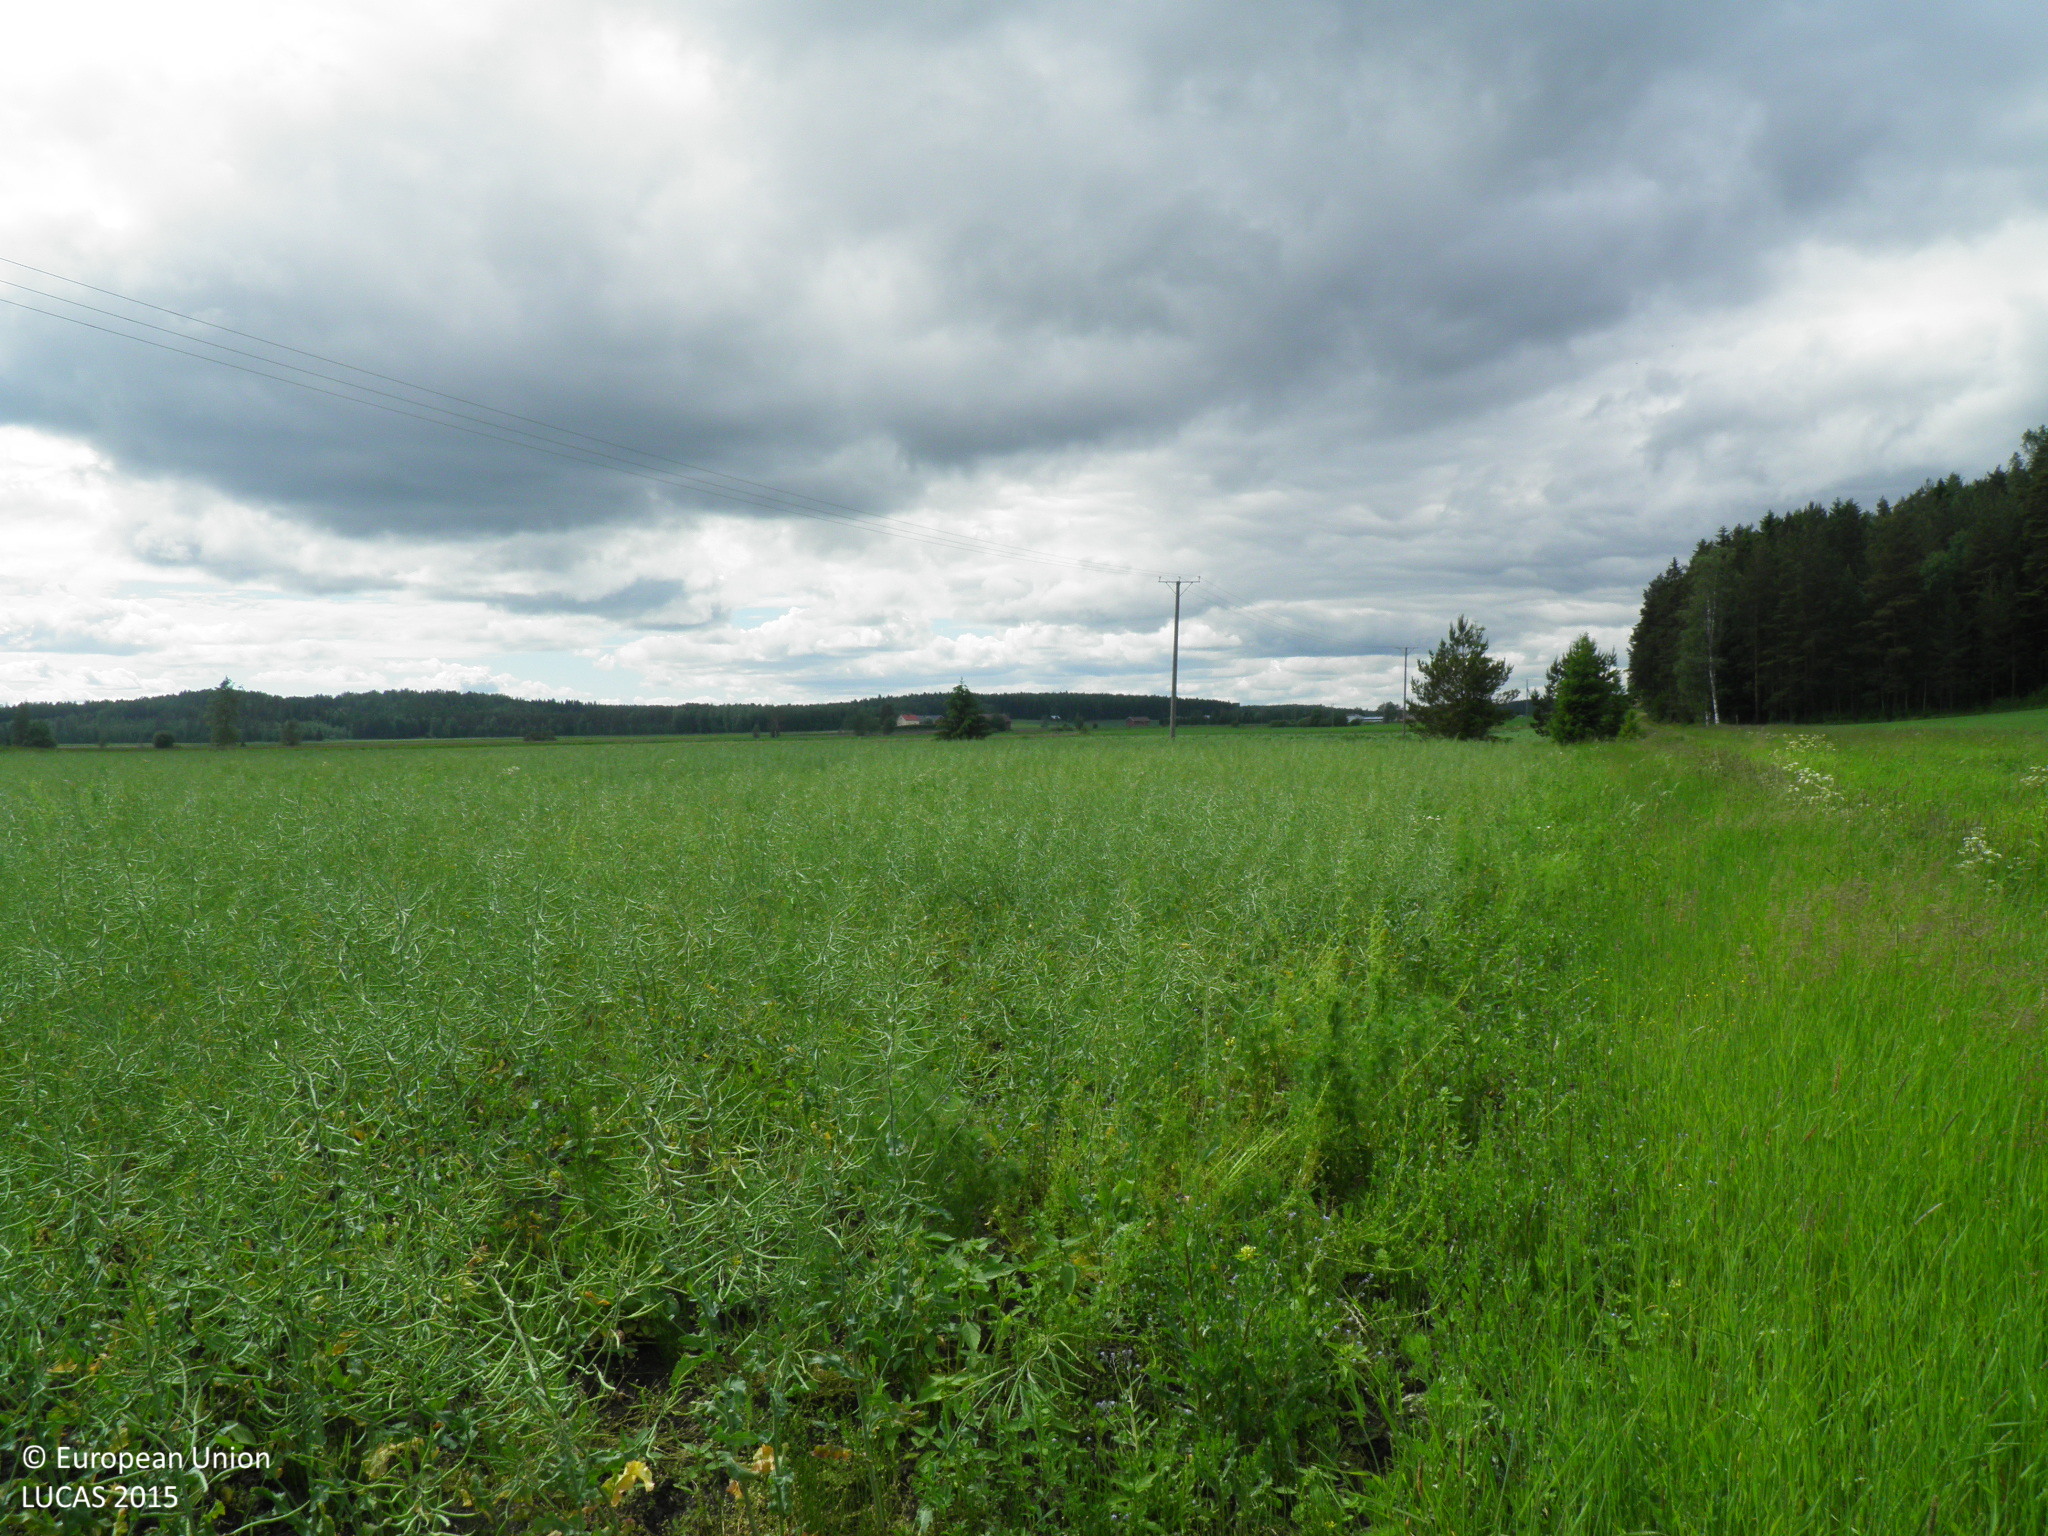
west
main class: Cropland
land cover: Rape and turnip rape
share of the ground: > 75 %
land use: Agriculture (excluding fallow land and kitchen gardens)
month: June
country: FI
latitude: 60.4099
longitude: 22.8760
